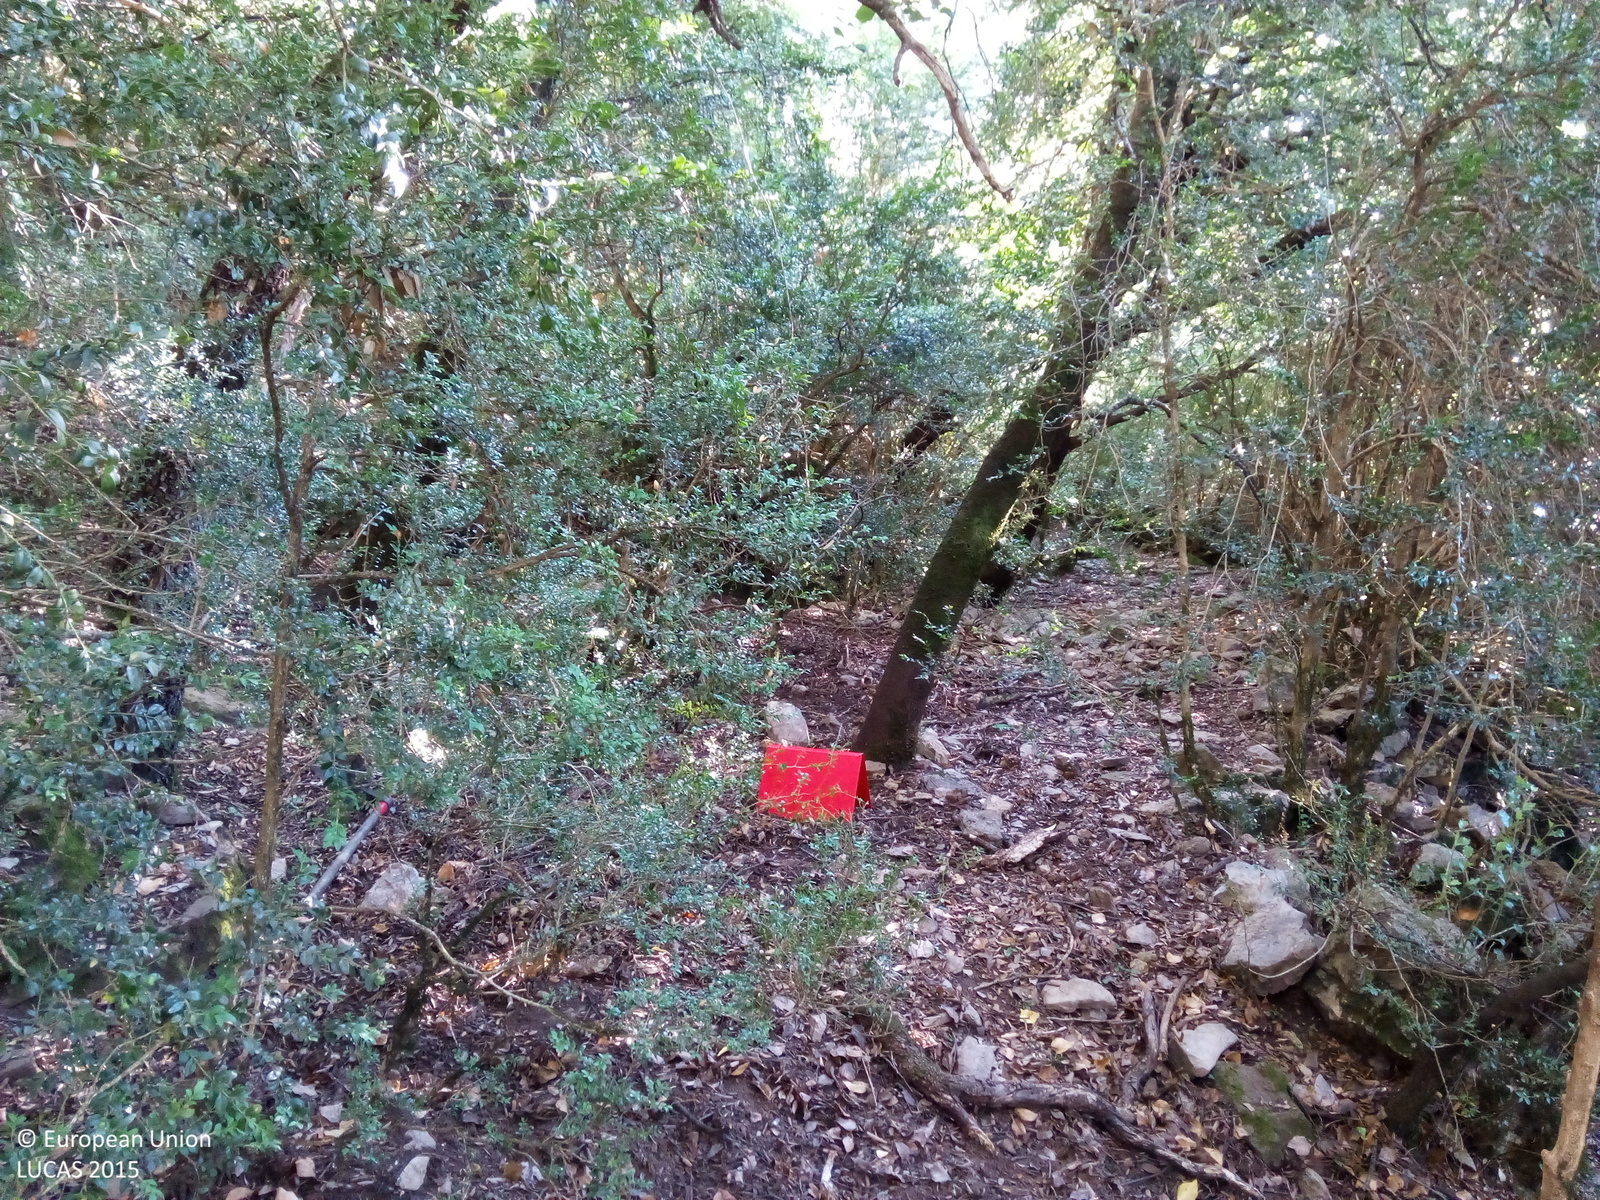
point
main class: Woodland
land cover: Broadleaved woodland
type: broadleaved evergreen forest
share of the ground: > 75 %
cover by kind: broadleaved forest trees 100 %
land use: Semi-natural and natural areas not in use
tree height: > 5 m
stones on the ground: 25 - 50 %
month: August
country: ES
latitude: 42.5926
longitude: 0.1675
